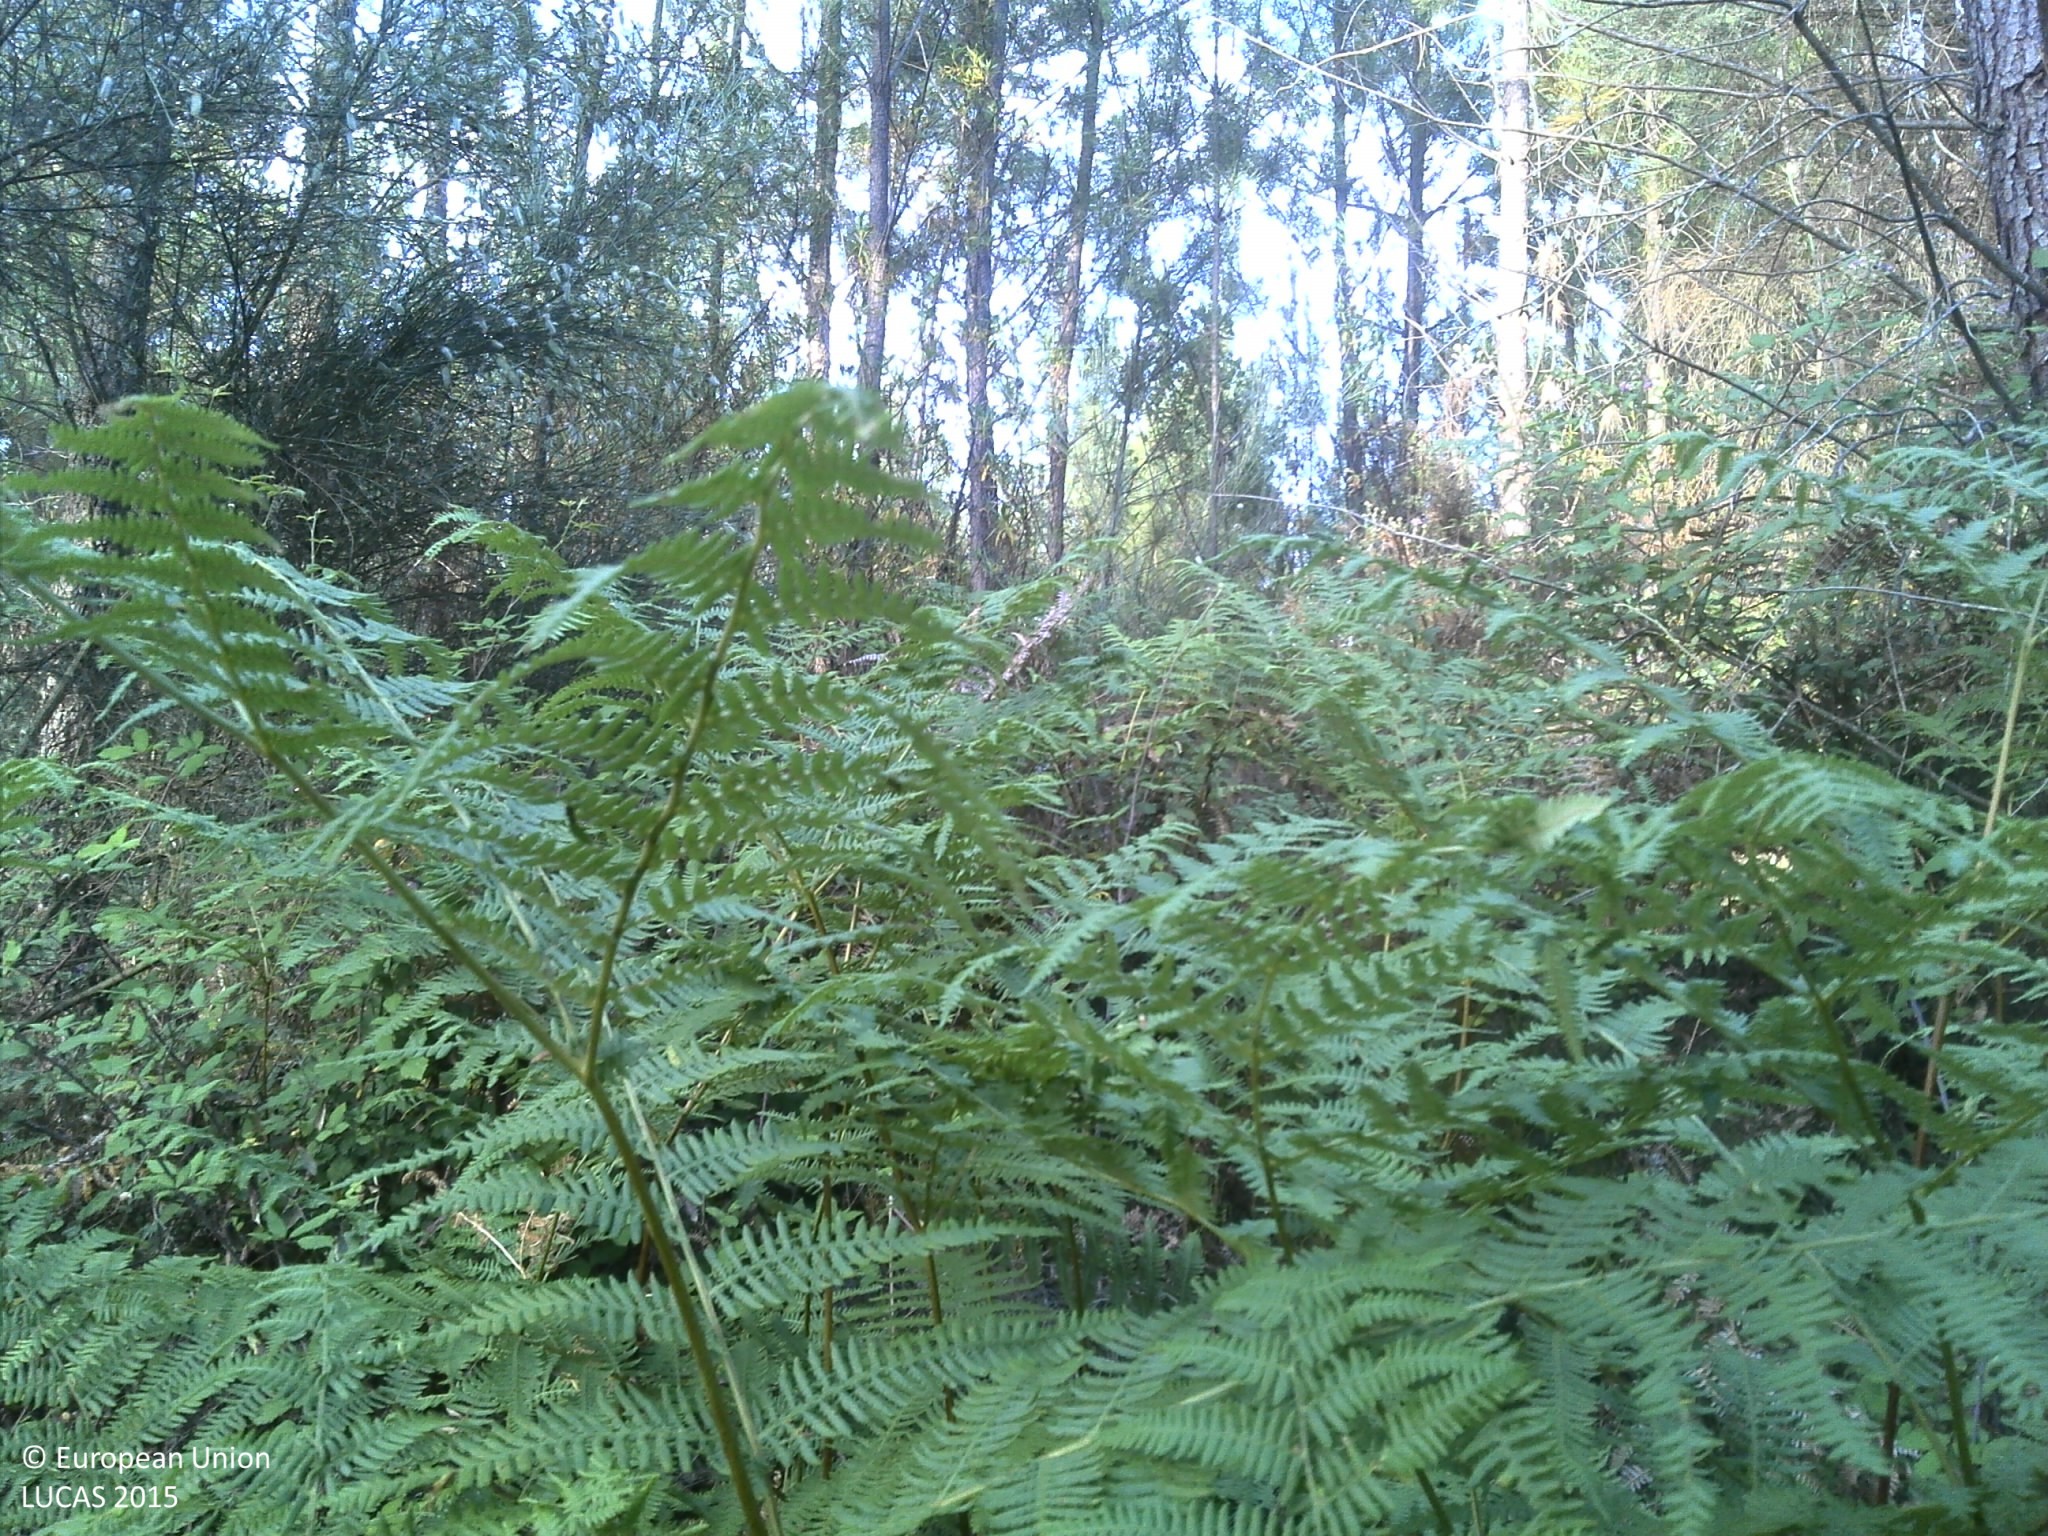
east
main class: Woodland
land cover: Pine dominated mixed woodland
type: coniferous forest of the mediterranean region
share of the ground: 25 - 50 %
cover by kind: coniferous forest trees 50 %, broadleaved forest trees 25 %, shrubs 20 %, unconsolidated bare surface 5 %
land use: Forestry
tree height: < 5 m
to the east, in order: Pine dominated mixed woodland; Shrubland without tree cover; Tracks; Shrubland with sparse tree cover; Broadleaved woodland; Tracks; Broadleaved woodland; Tracks; Other bare soil
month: June
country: PT
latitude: 39.4308
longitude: -7.9356
